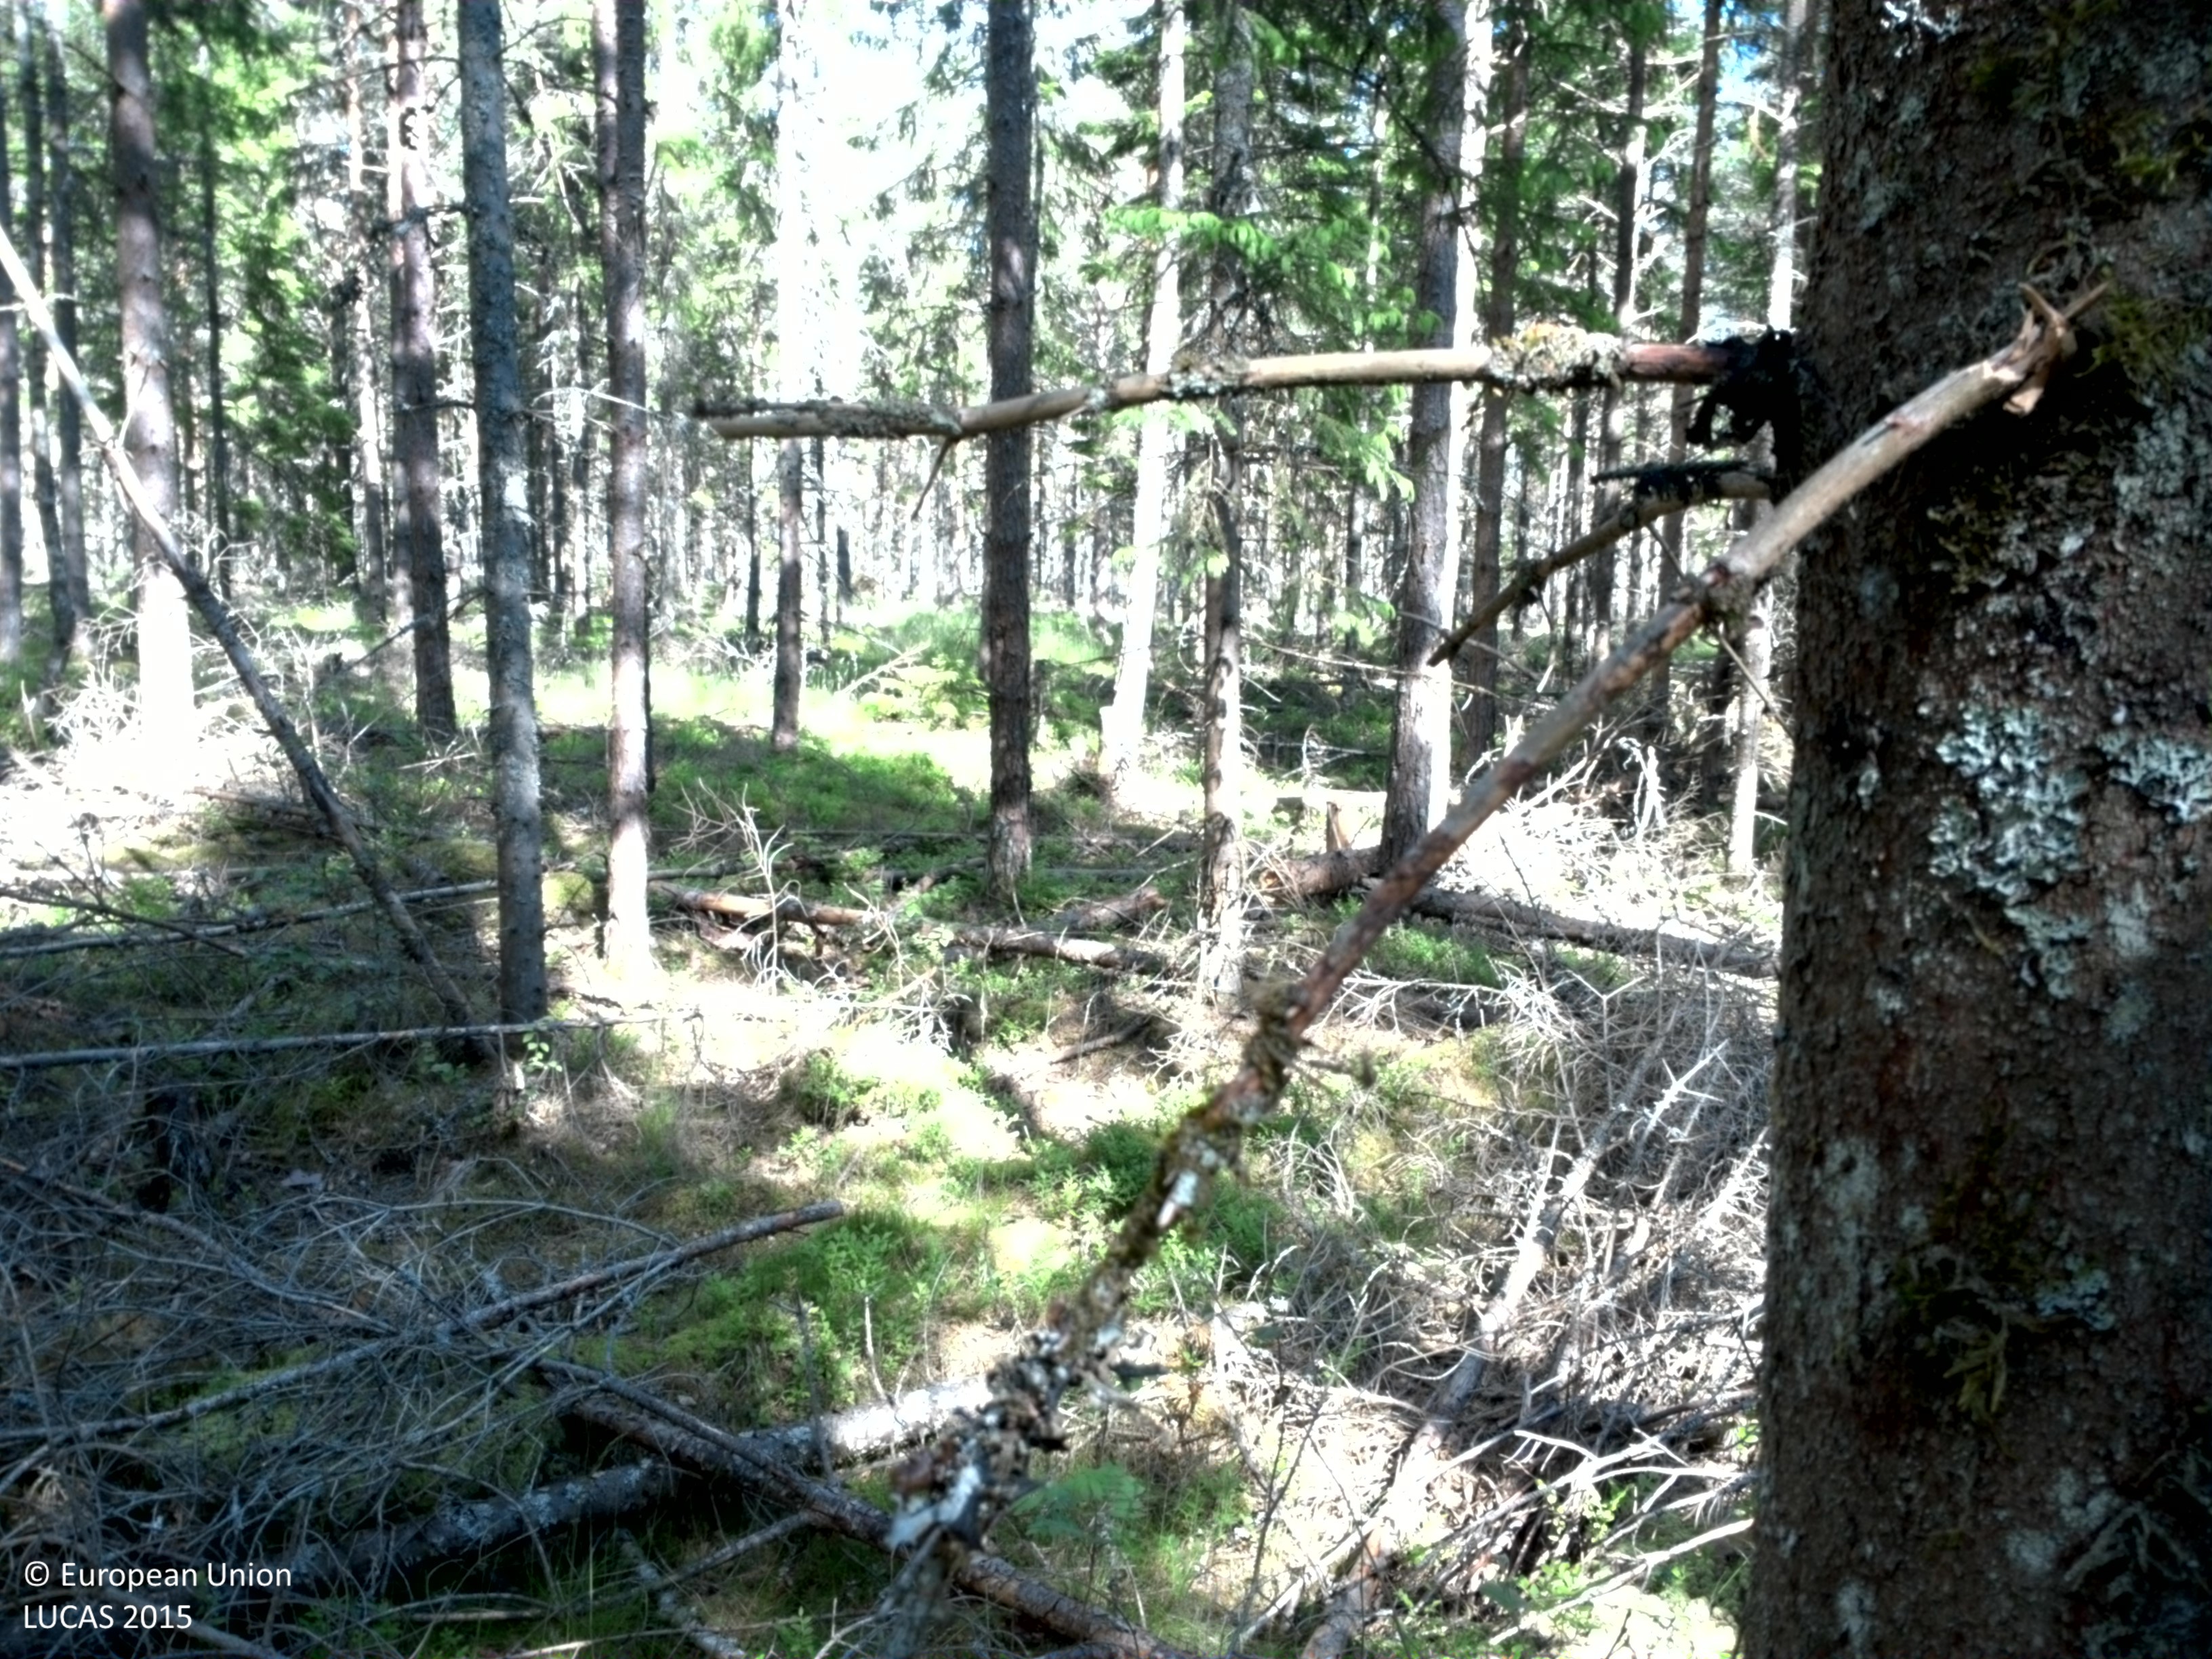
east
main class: Woodland
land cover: Pine dominated coniferous woodland
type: boreal forest
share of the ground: 50 - 75 %
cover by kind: coniferous forest trees 65 %, lichens and mosses 25 %, broadleaved forest trees 10 %
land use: Forestry
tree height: > 5 m
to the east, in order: Pine dominated coniferous woodland; Spontaneously vegetated surfaces; Rivers and streams; Spontaneously vegetated surfaces; Ditches and canals; Paved roads, cycling and walking lanes; Ditches and canals; Pine dominated coniferous woodland
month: June
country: SE
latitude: 57.7854
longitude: 13.8801
